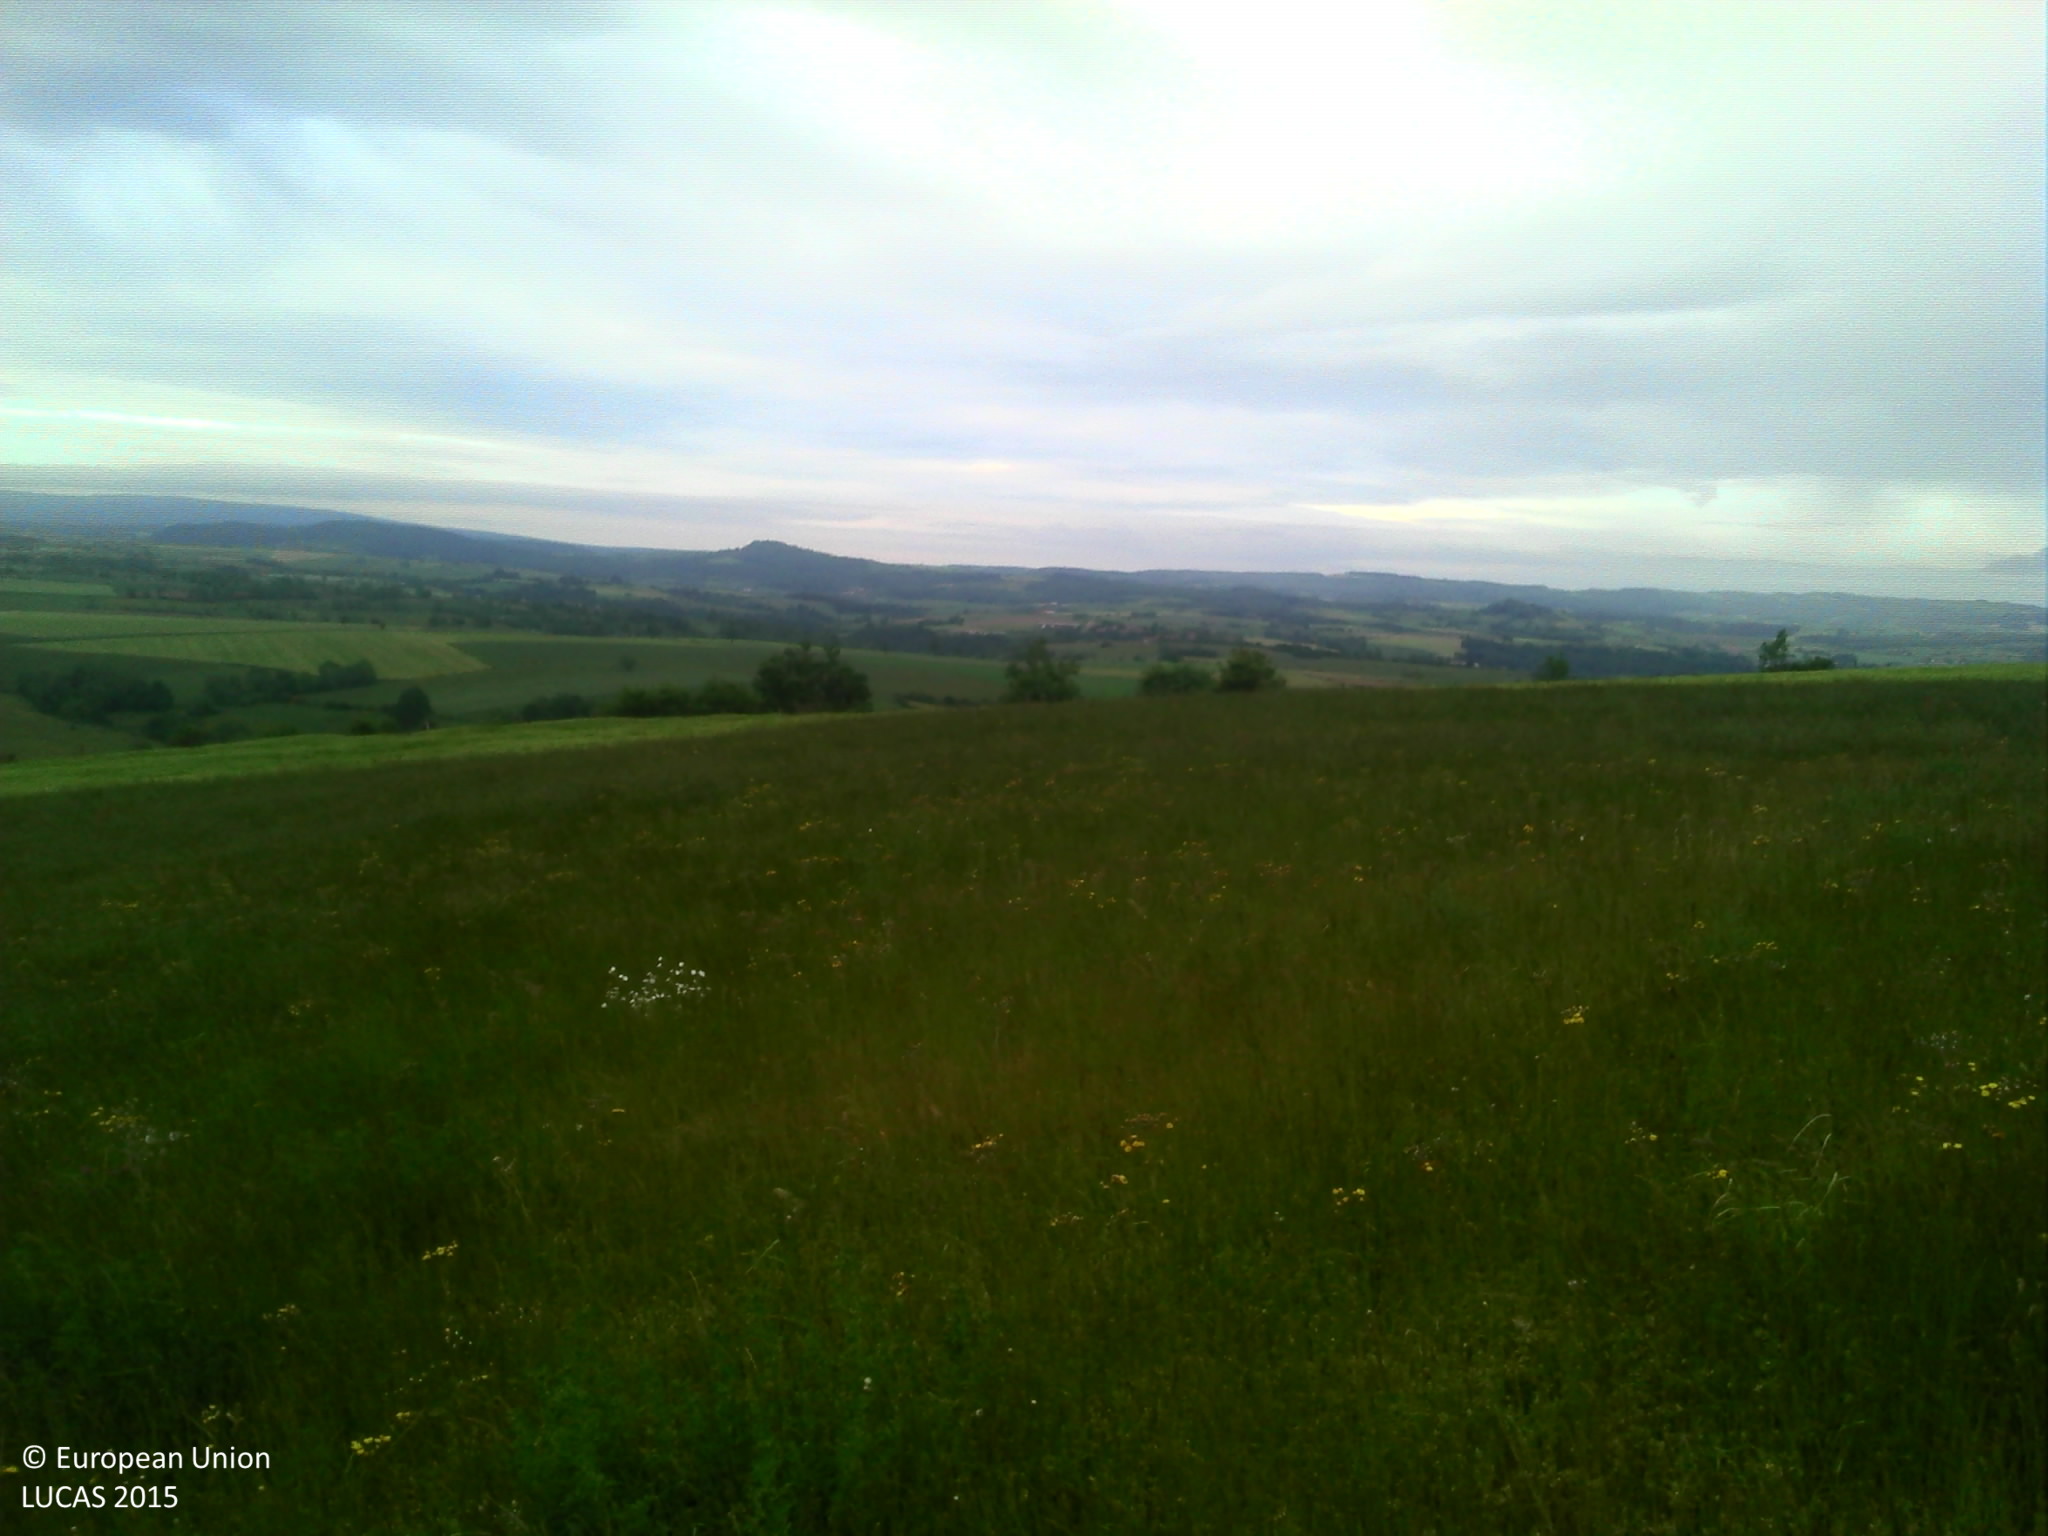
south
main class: Grassland
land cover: Grassland without tree/shrub cover
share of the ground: > 75 %
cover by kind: herbaceous plants 100 %
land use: Agriculture (excluding fallow land and kitchen gardens)
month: June
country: FR
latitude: 45.1778
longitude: 3.2196
